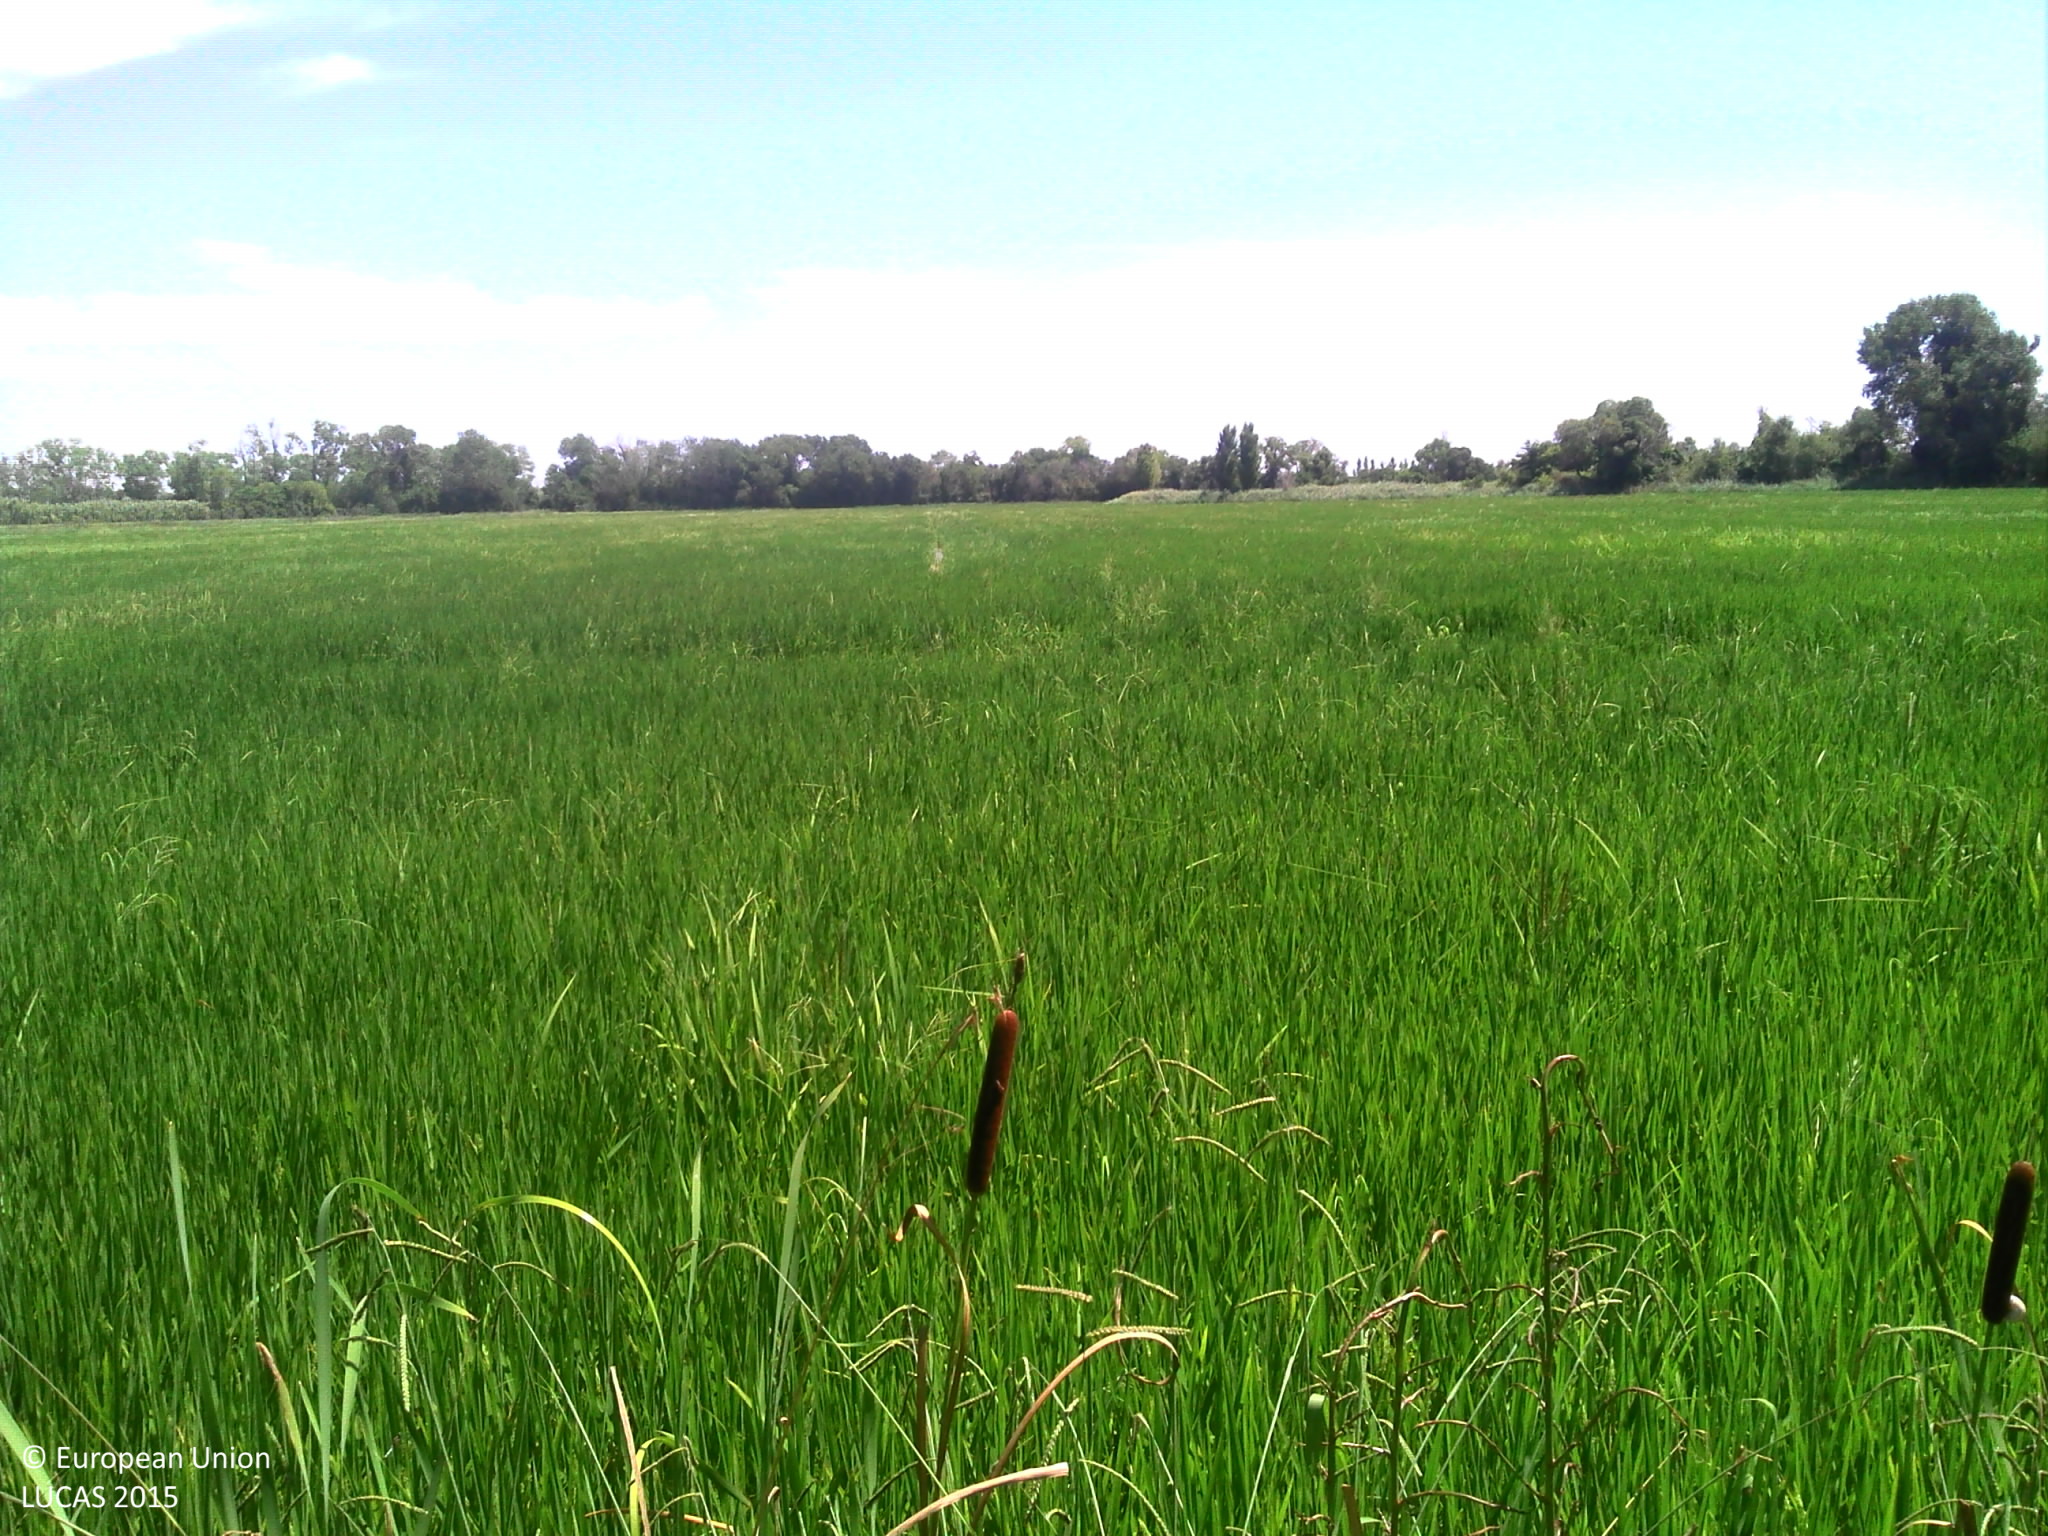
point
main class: Cropland
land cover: Rice
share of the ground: > 75 %
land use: Agriculture (excluding fallow land and kitchen gardens)
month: July
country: FR
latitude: 43.4768
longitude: 4.7559
